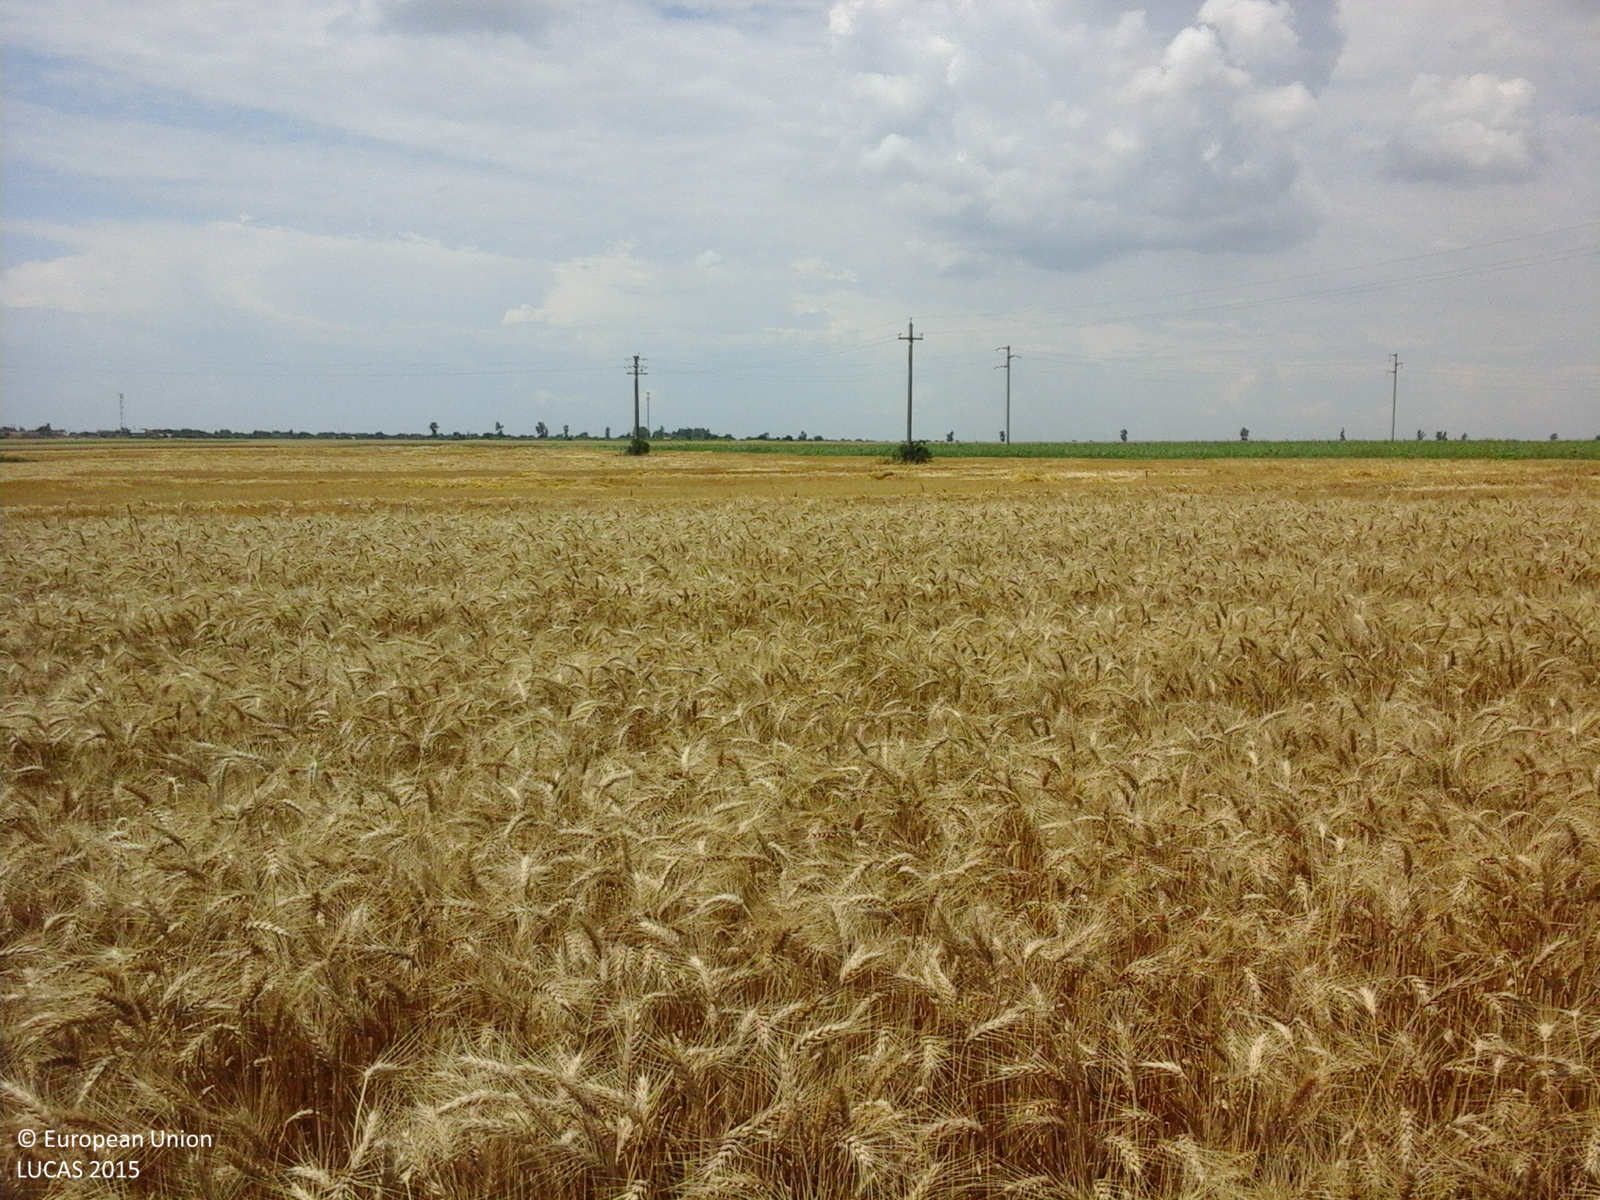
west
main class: Cropland
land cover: Common wheat
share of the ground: > 75 %
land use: Agriculture (excluding fallow land and kitchen gardens)
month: June
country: RO
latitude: 44.1244
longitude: 26.3670
